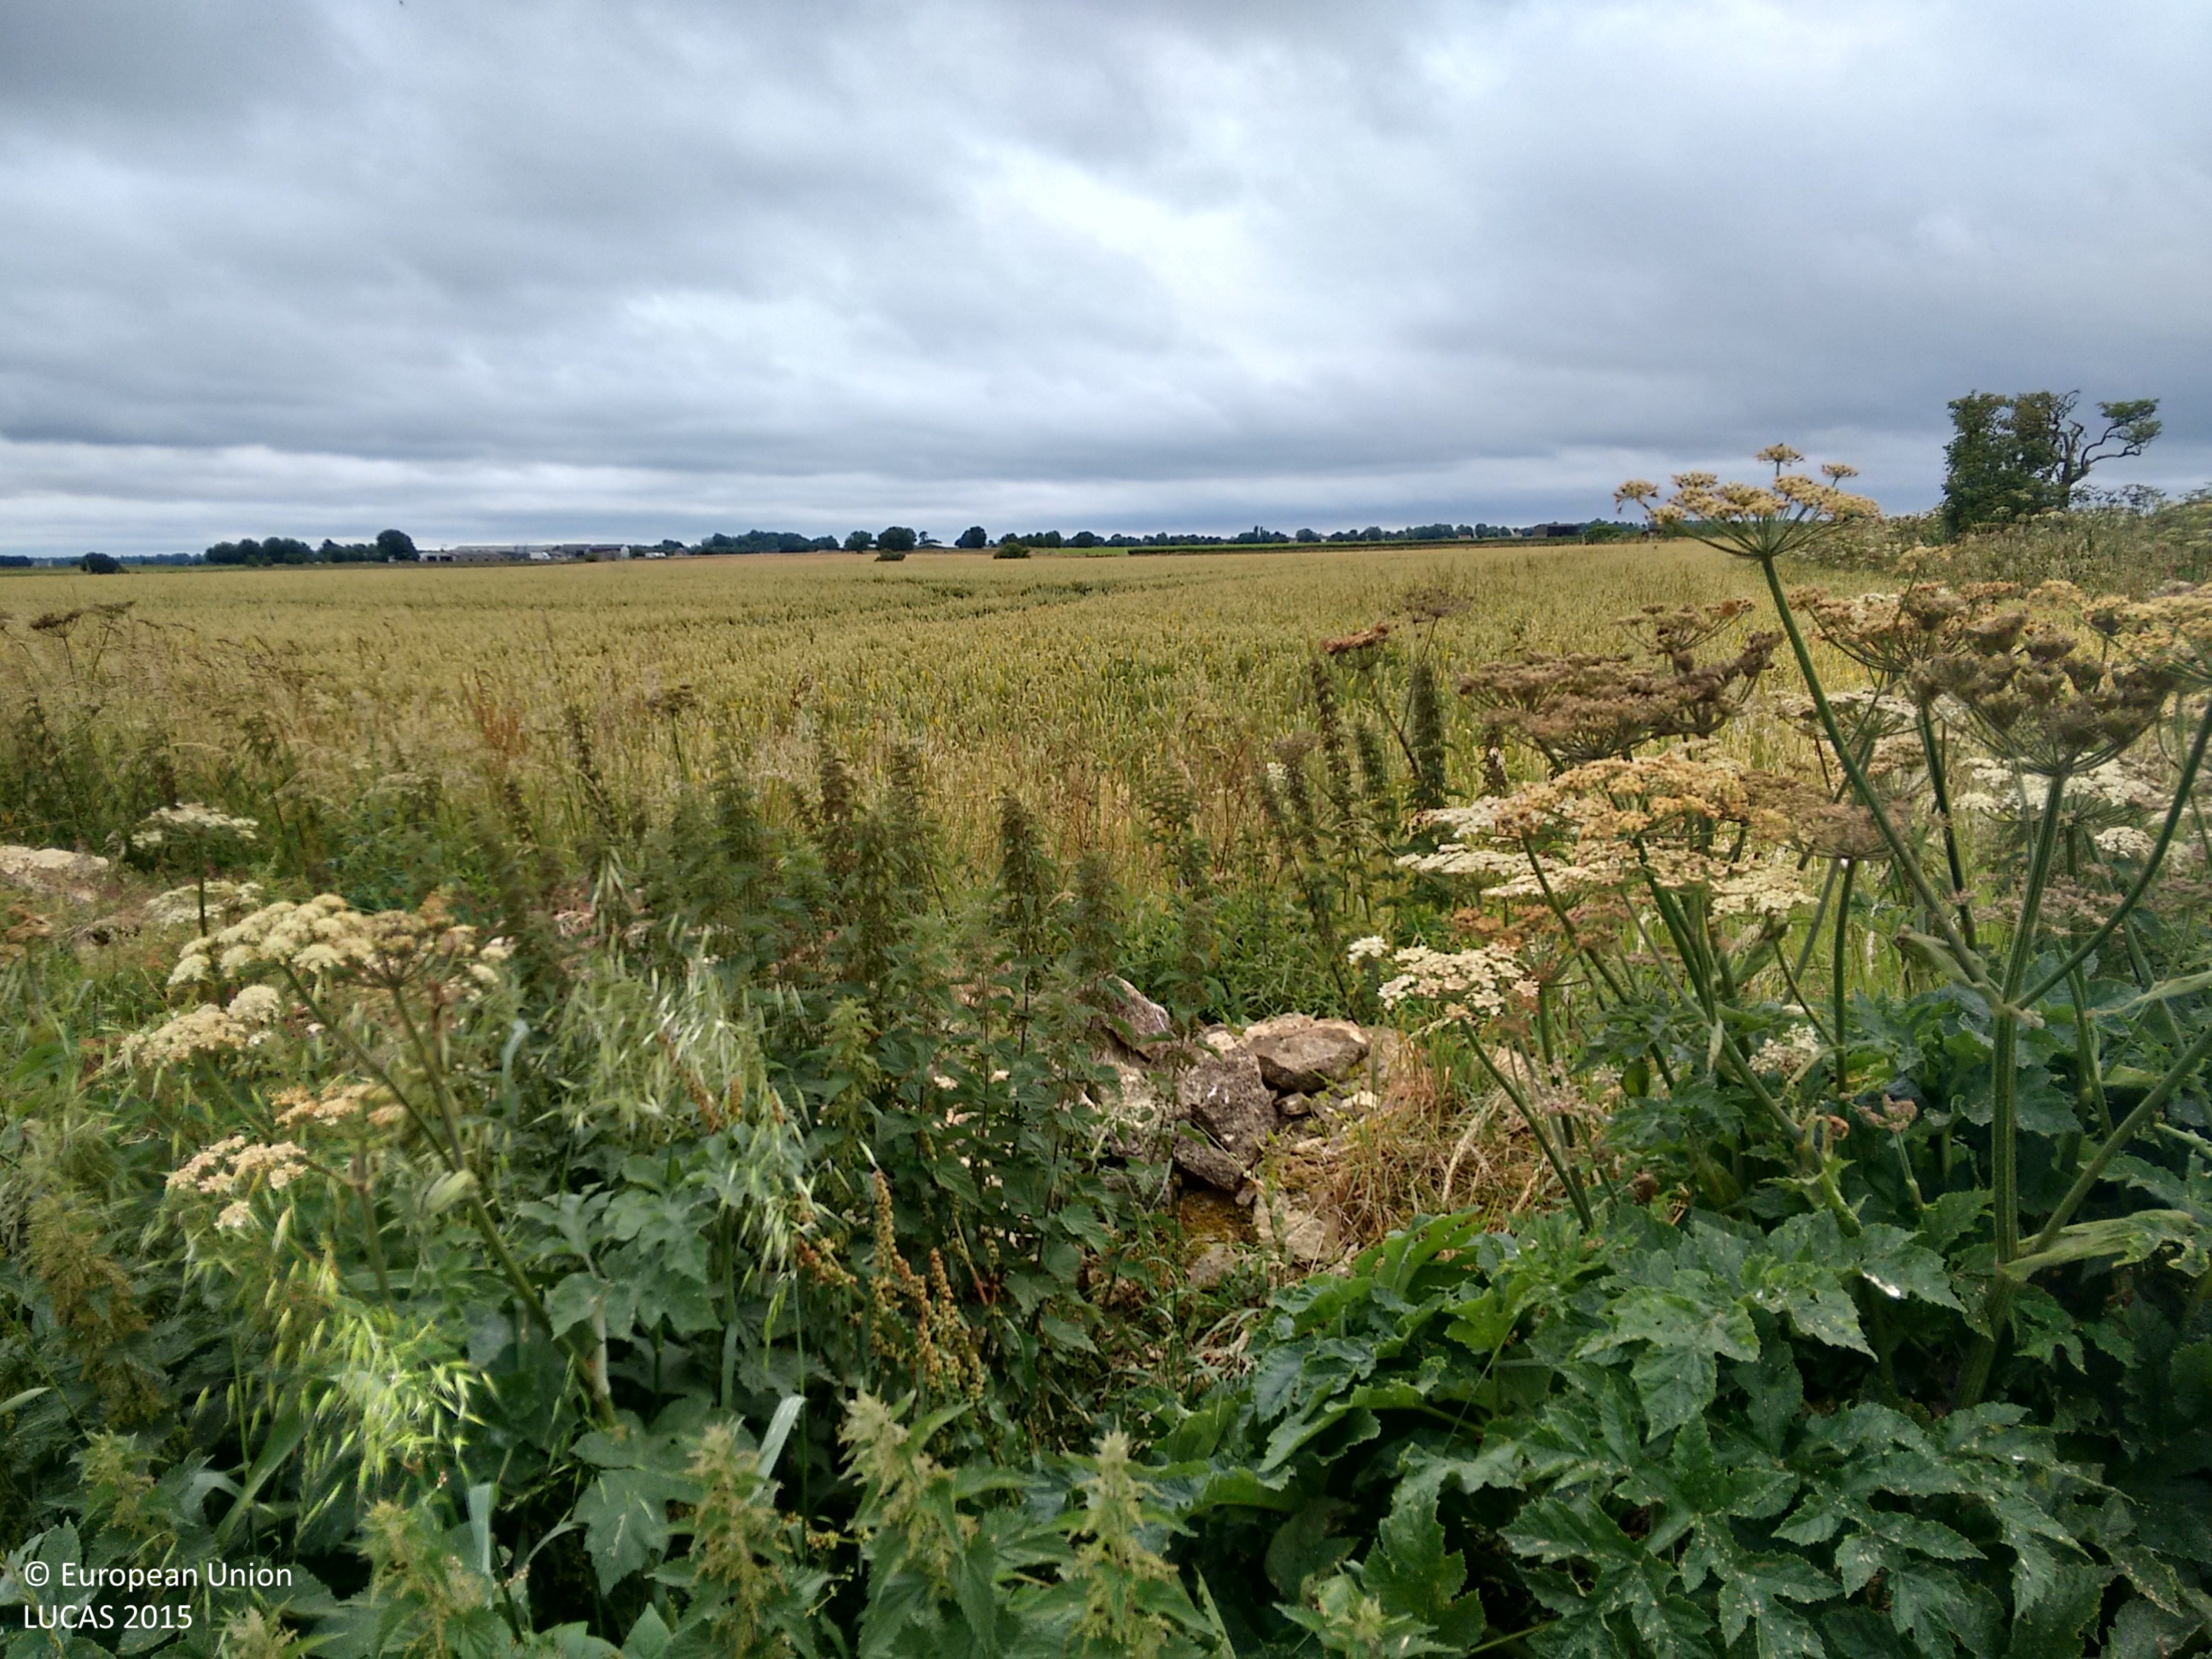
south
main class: Cropland
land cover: Common wheat
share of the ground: > 75 %
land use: Agriculture (excluding fallow land and kitchen gardens)
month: July
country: GB
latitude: 51.4783
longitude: -2.3167
